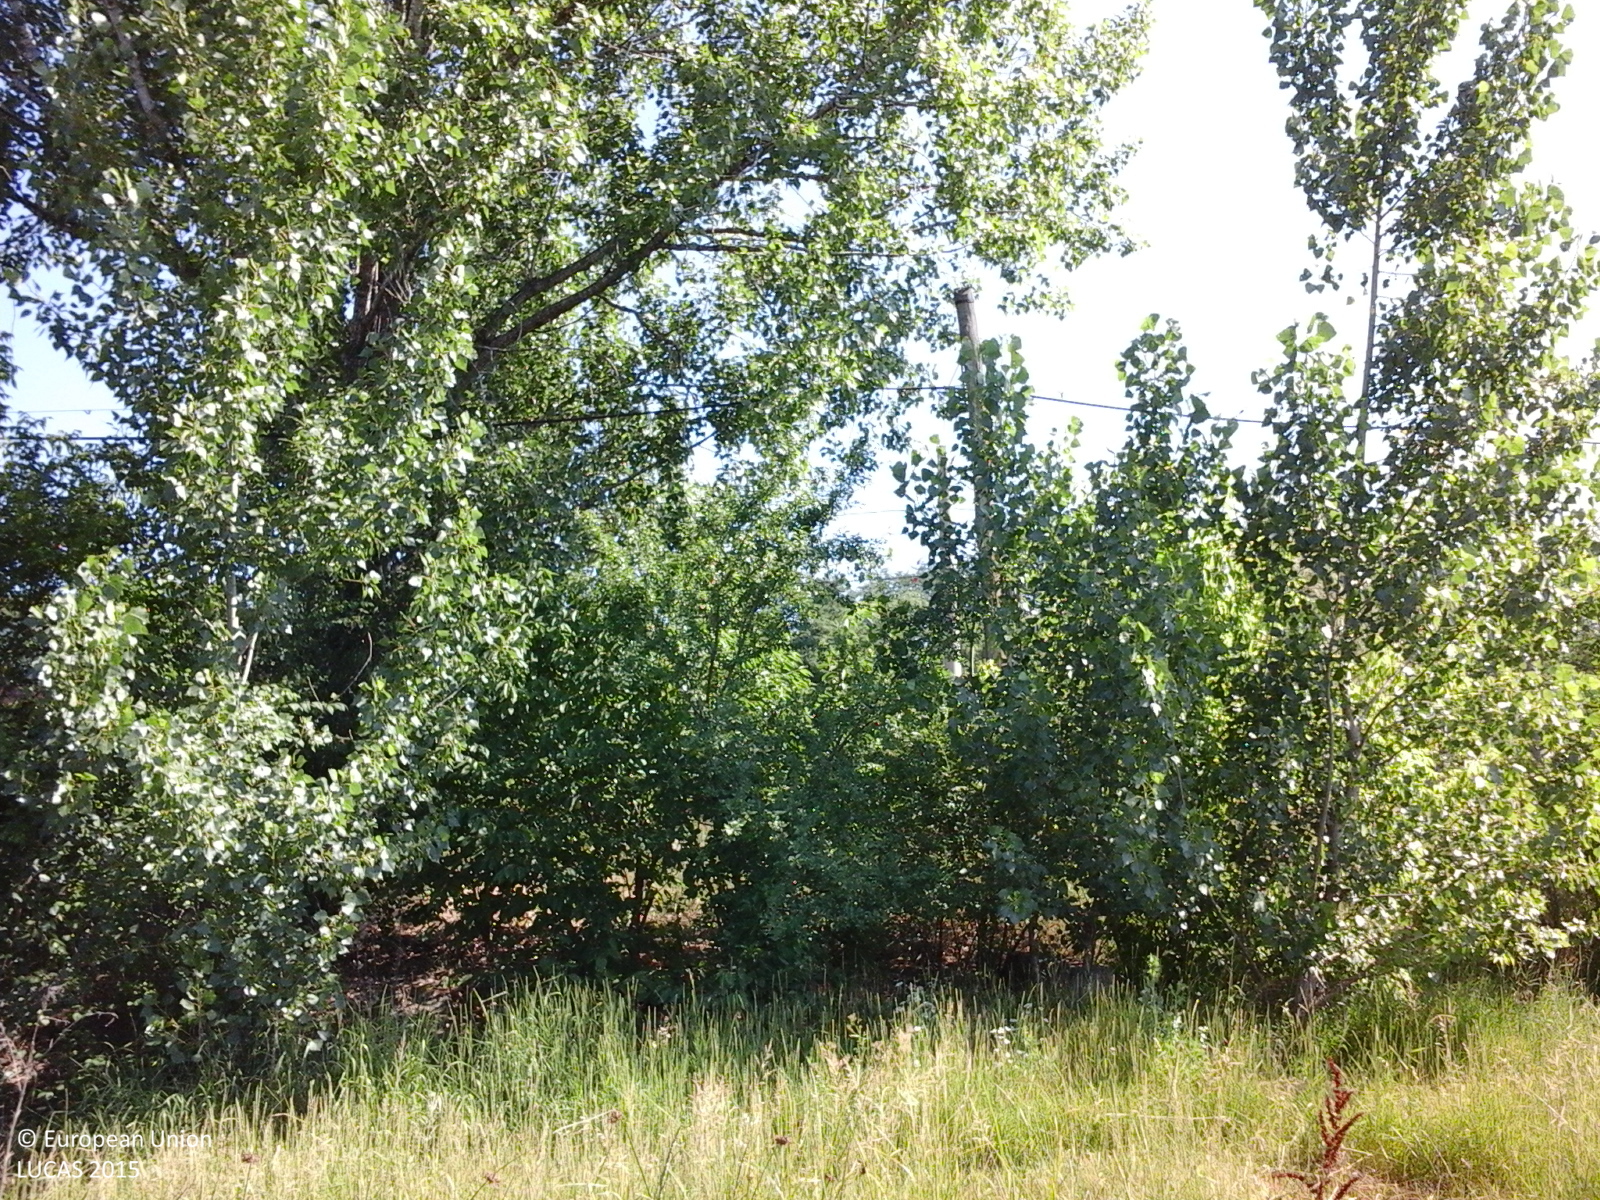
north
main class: Grassland
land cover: Grassland with sparse tree/shrub cover
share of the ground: > 75 %
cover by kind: herbaceous plants 90 %, broadleaved forest trees 5 %, shrubs 5 %
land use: Semi-natural and natural areas not in use
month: June
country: RO
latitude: 47.1527
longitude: 27.6481
